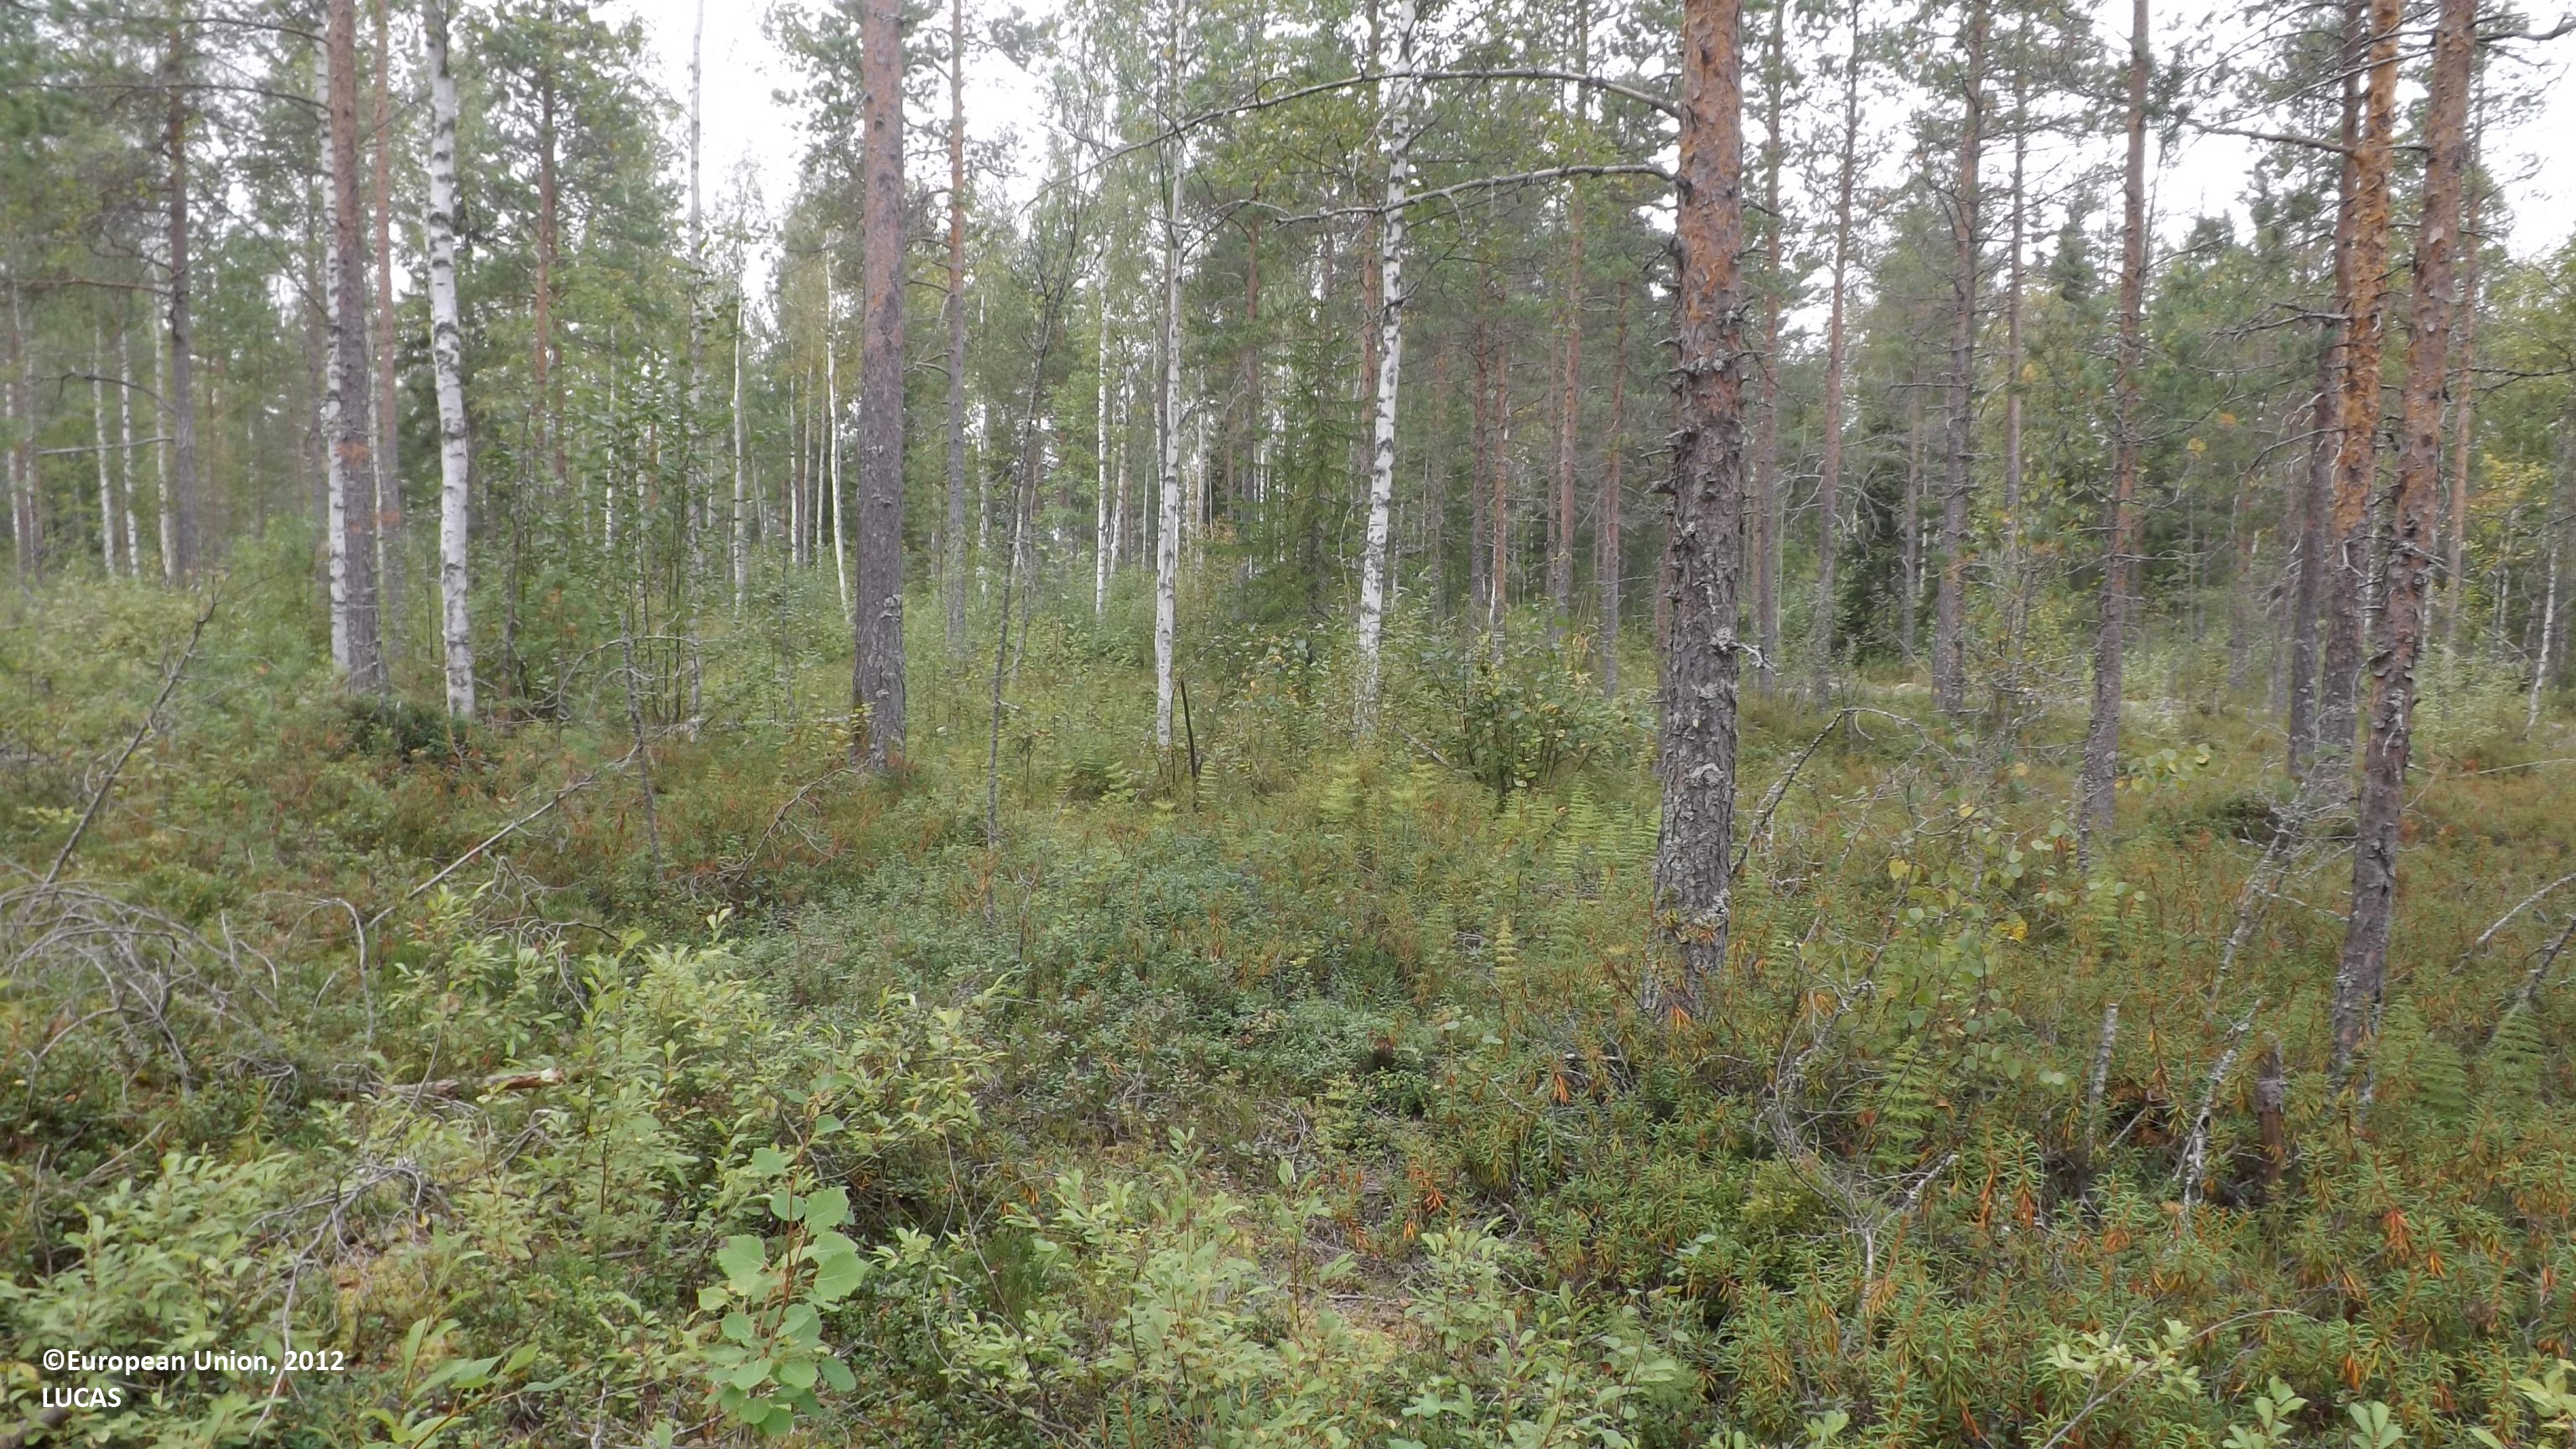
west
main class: Woodland
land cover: Pine dominated mixed woodland
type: boreal forest
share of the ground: 25 - 50 %
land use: Forestry
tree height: > 5 m
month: August
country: FI
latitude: 63.8646
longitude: 24.2122
